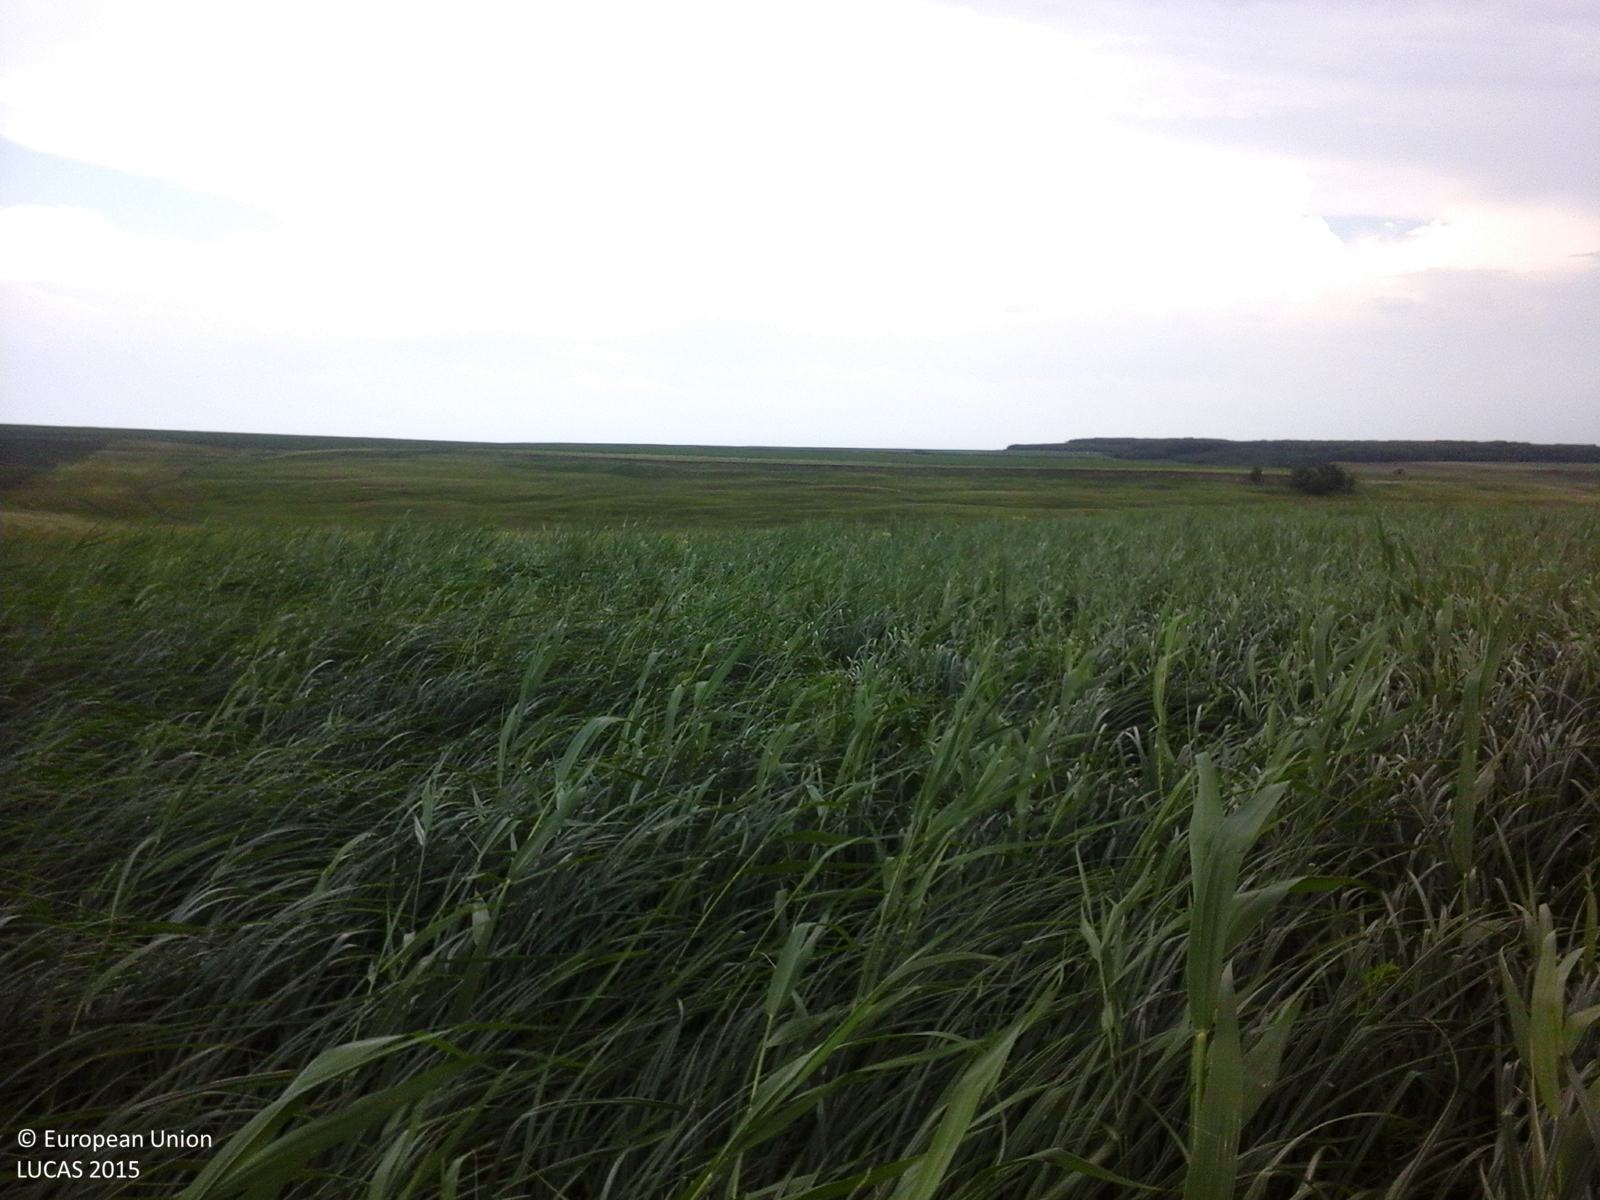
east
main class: Grassland
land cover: Grassland without tree/shrub cover
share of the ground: > 75 %
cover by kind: herbaceous plants 100 %
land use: Agriculture (excluding fallow land and kitchen gardens)
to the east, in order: Grassland without tree/shrub cover
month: June
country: RO
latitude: 47.8923
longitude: 26.5850
